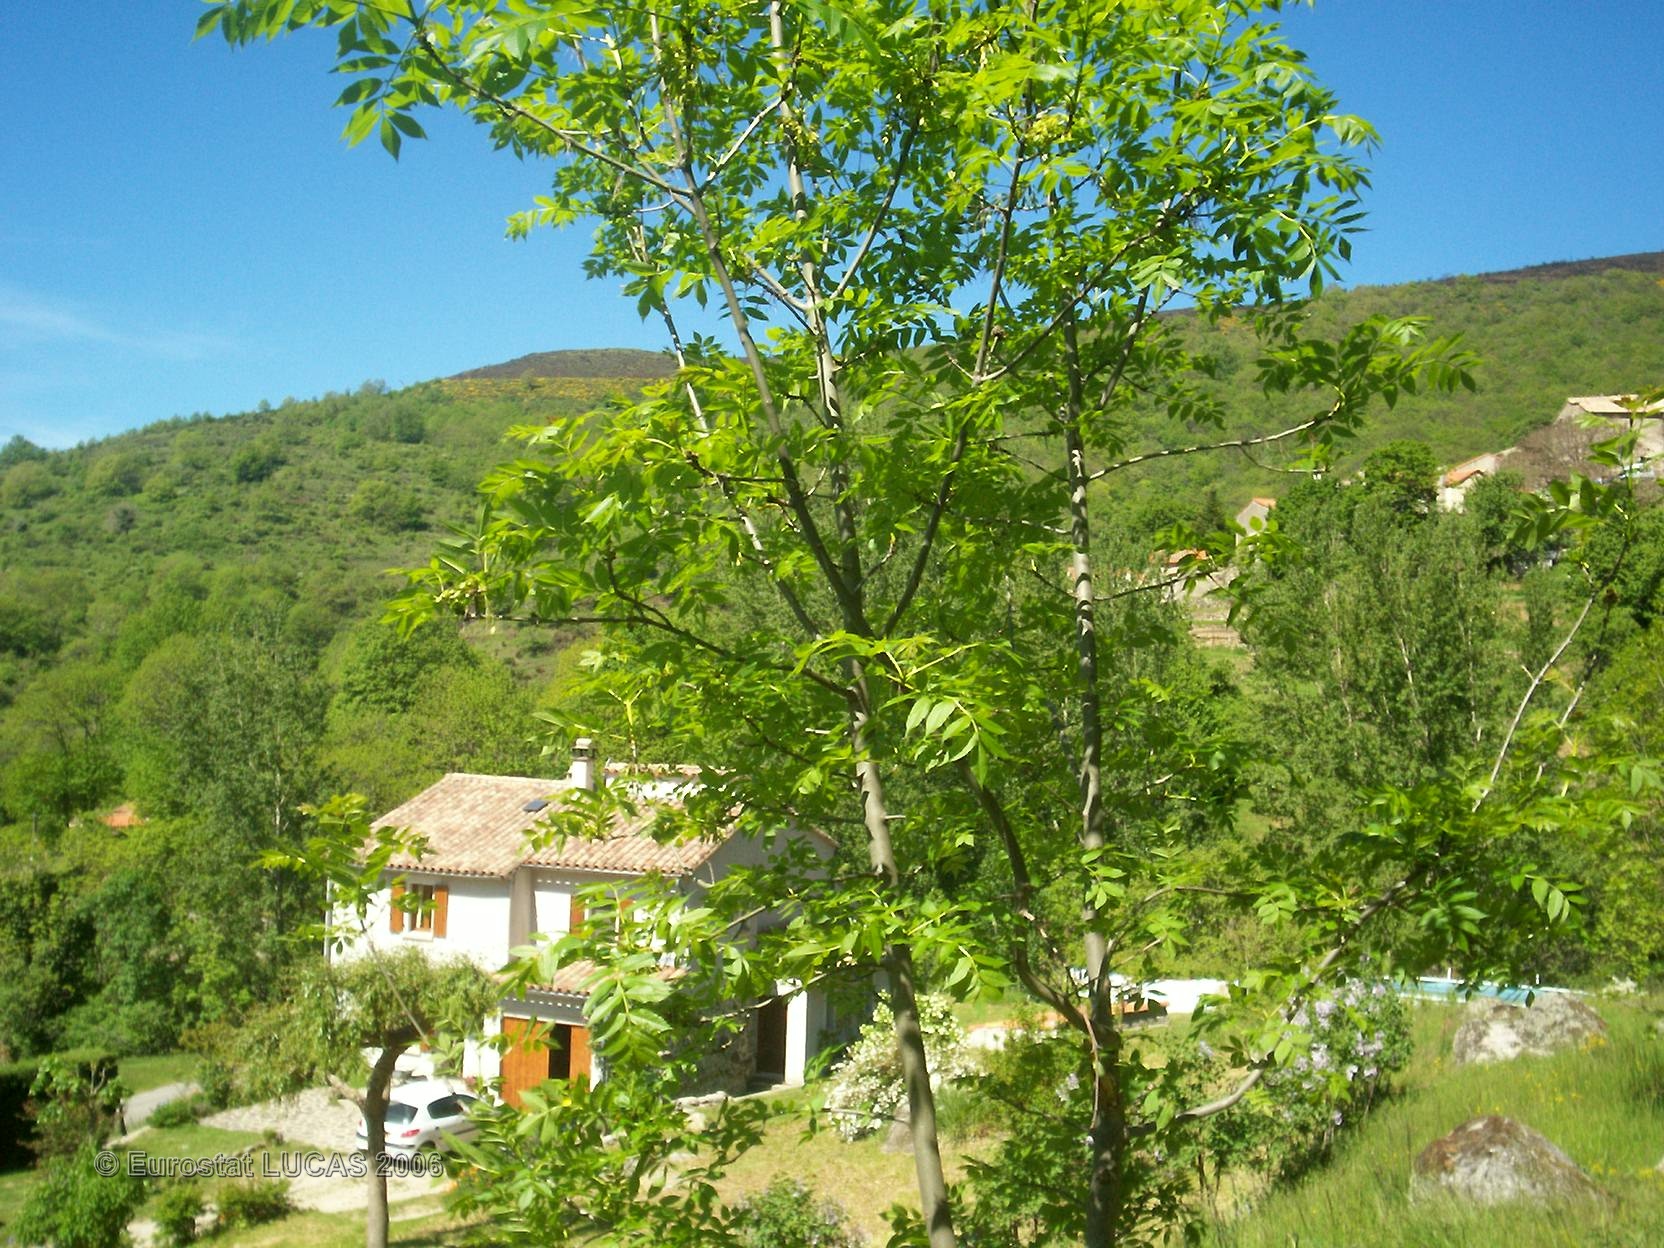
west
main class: Grassland
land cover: Grassland with sparse tree/shrub cover
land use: Residential
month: May
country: FR
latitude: 44.0010
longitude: 3.4848
